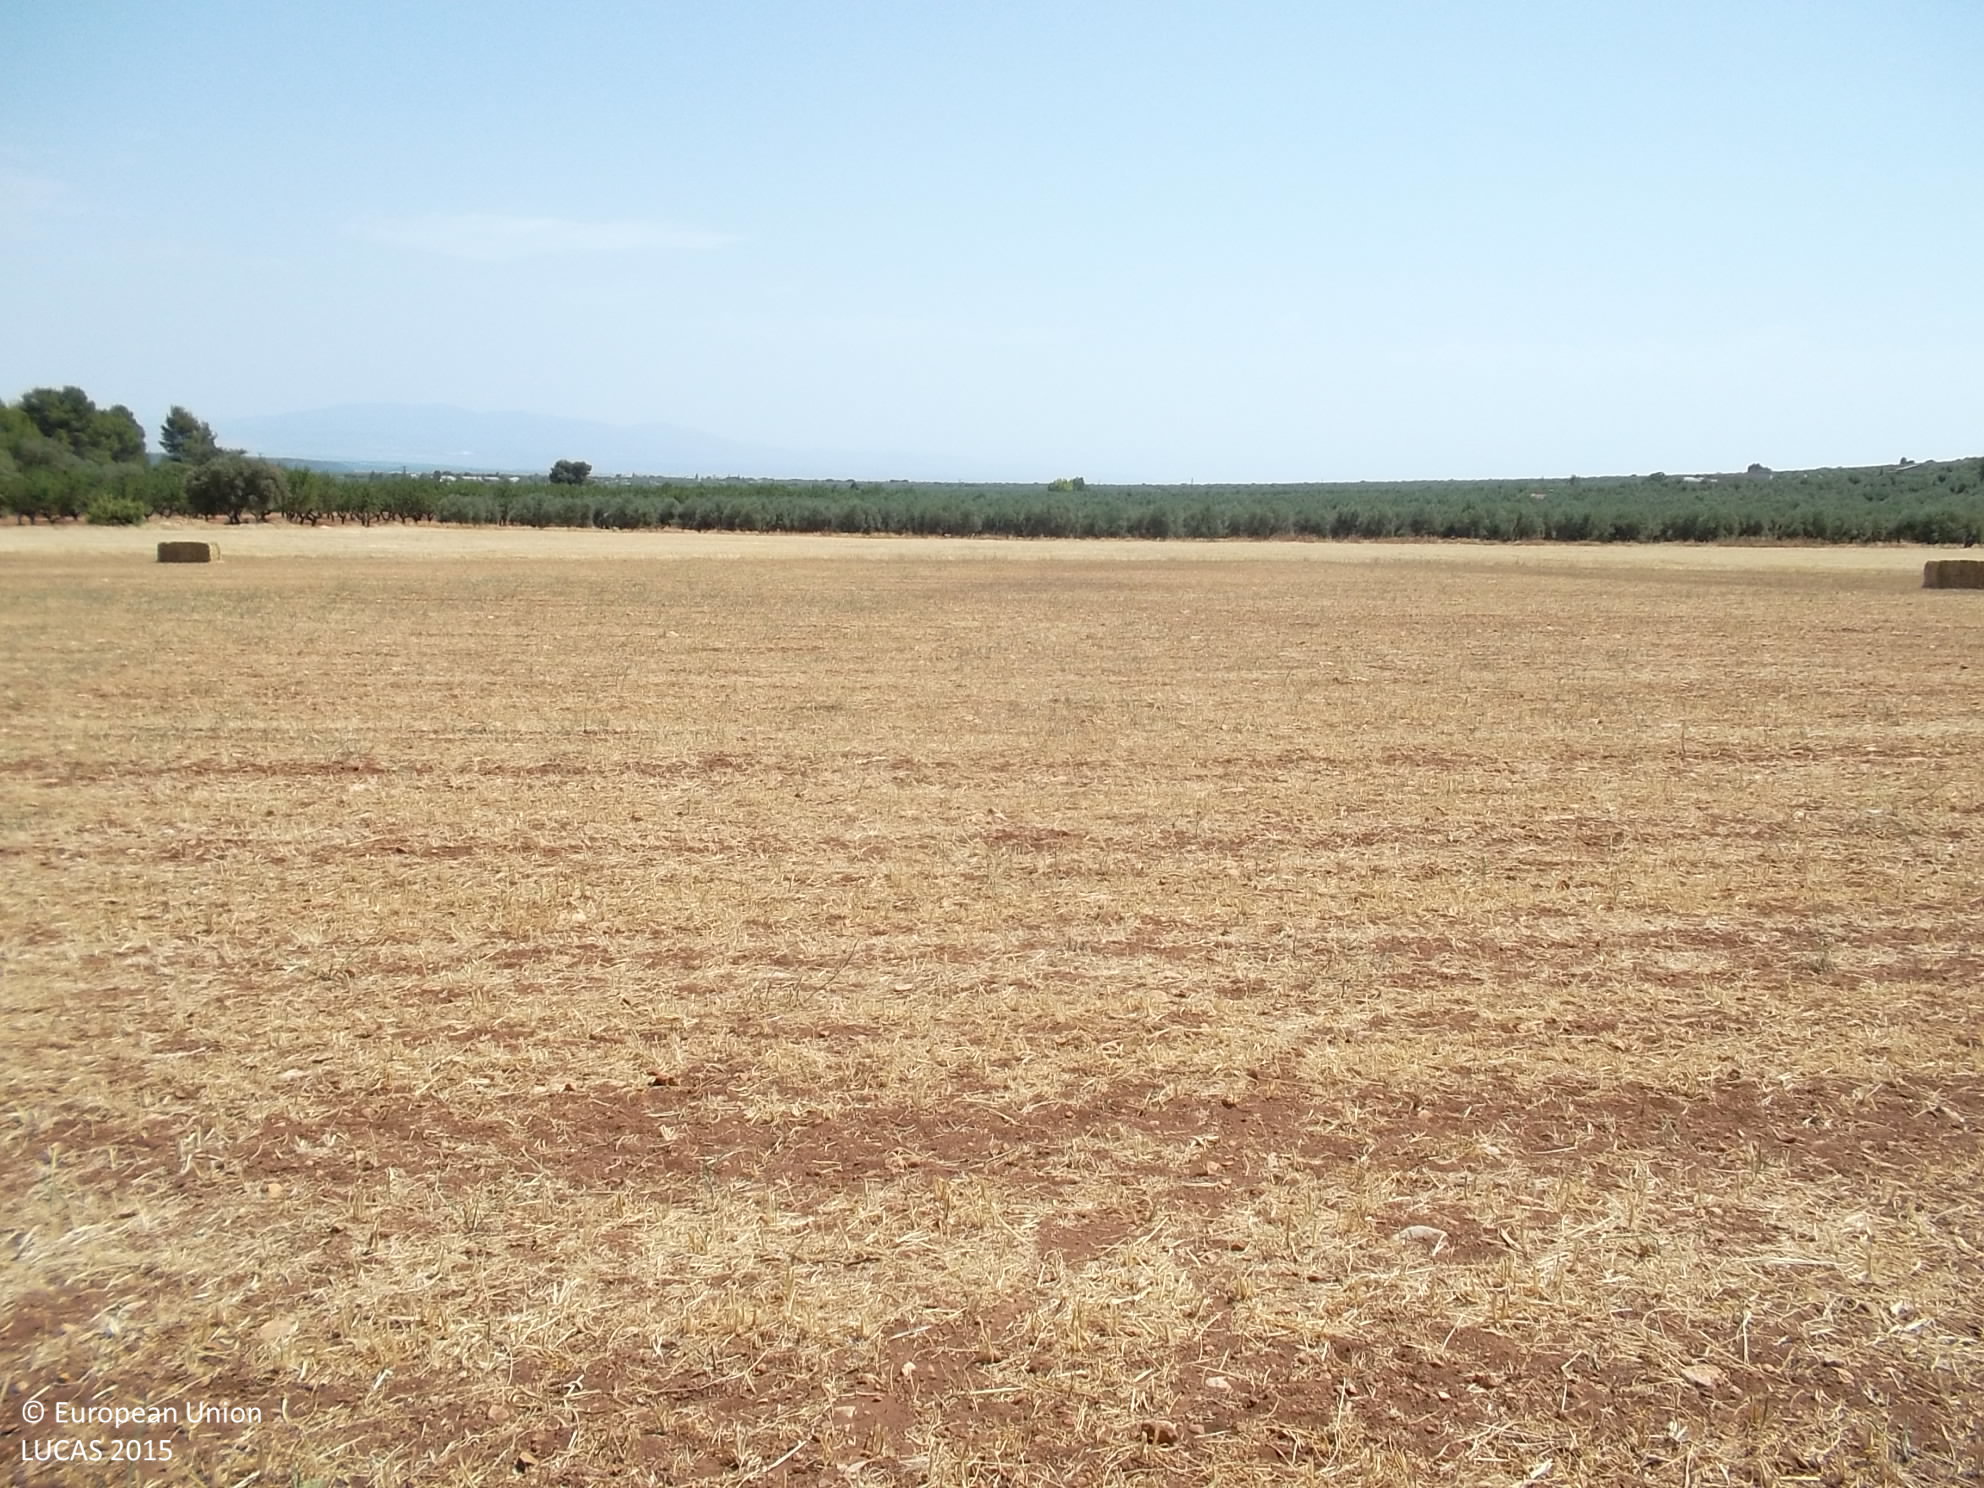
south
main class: Cropland
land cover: Olive groves
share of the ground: 25 - 50 %
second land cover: Other bare soil
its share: > 75 %
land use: Agriculture (excluding fallow land and kitchen gardens)
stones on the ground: 10 - 25 %
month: June
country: ES
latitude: 37.7606
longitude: -2.9211
